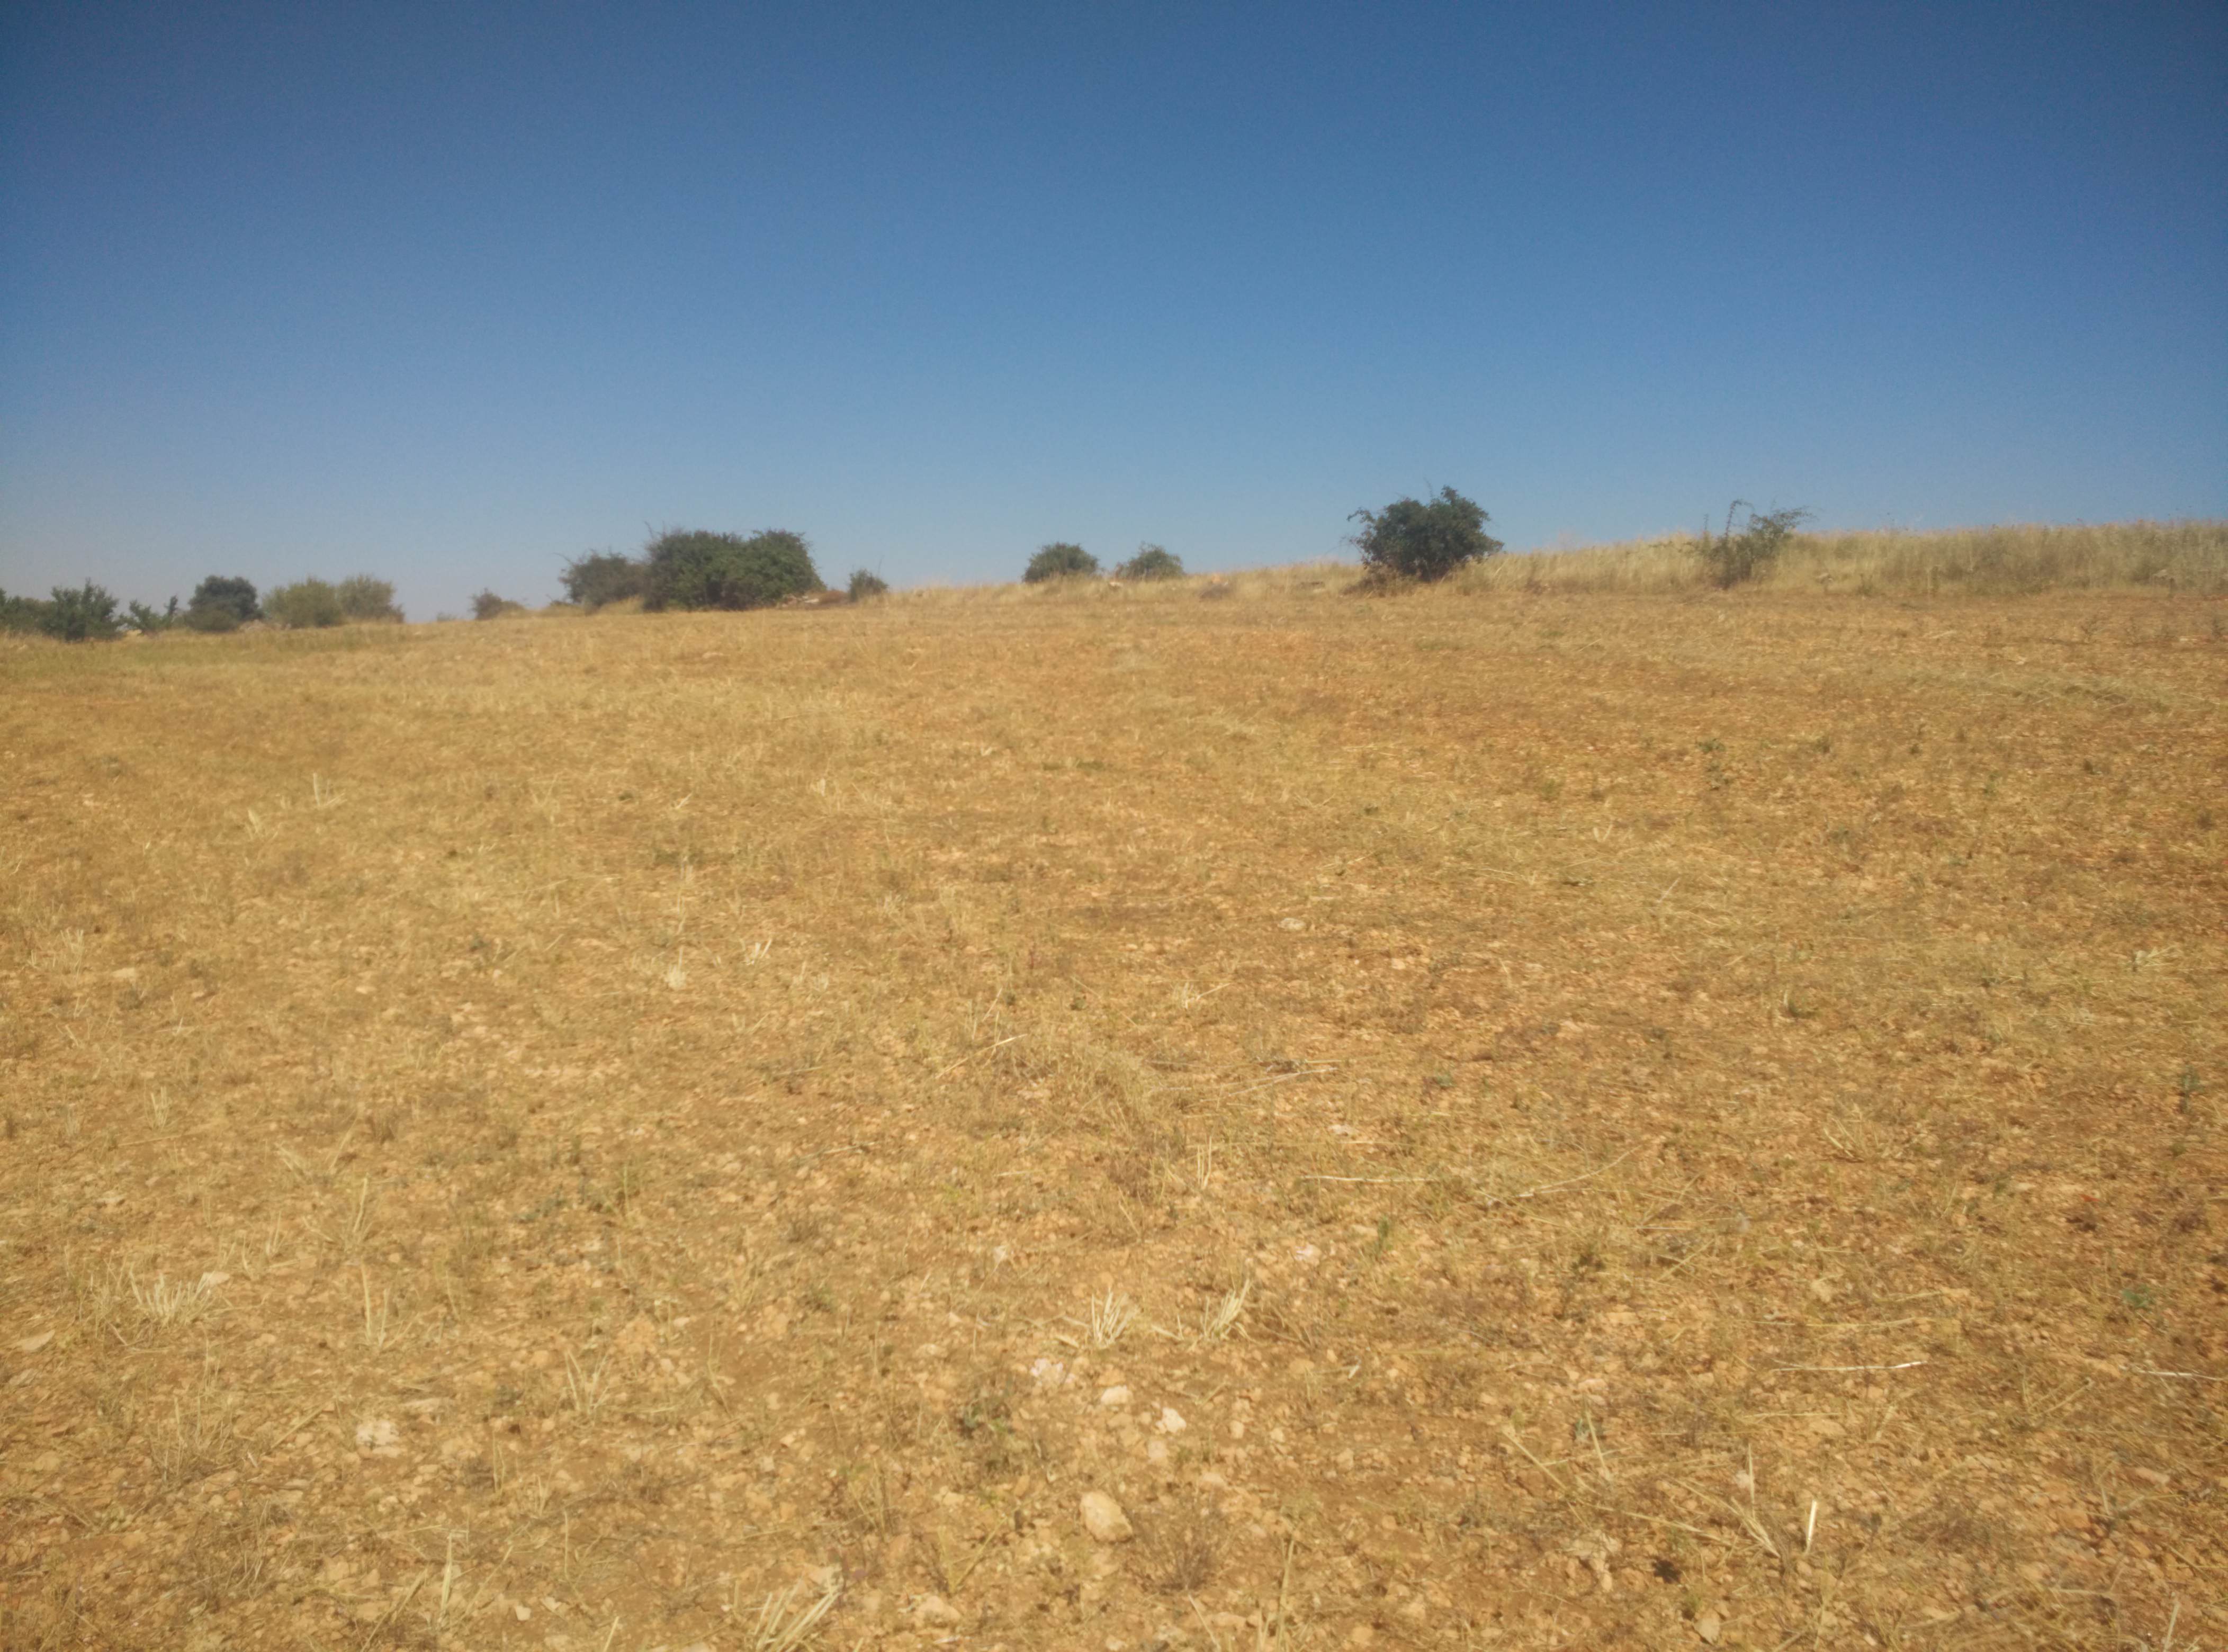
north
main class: Cropland
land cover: Common wheat
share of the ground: < 10 %
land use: Agriculture (excluding fallow land and kitchen gardens)
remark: Harvested field
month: July
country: ES
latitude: 40.6279
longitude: -2.8329
